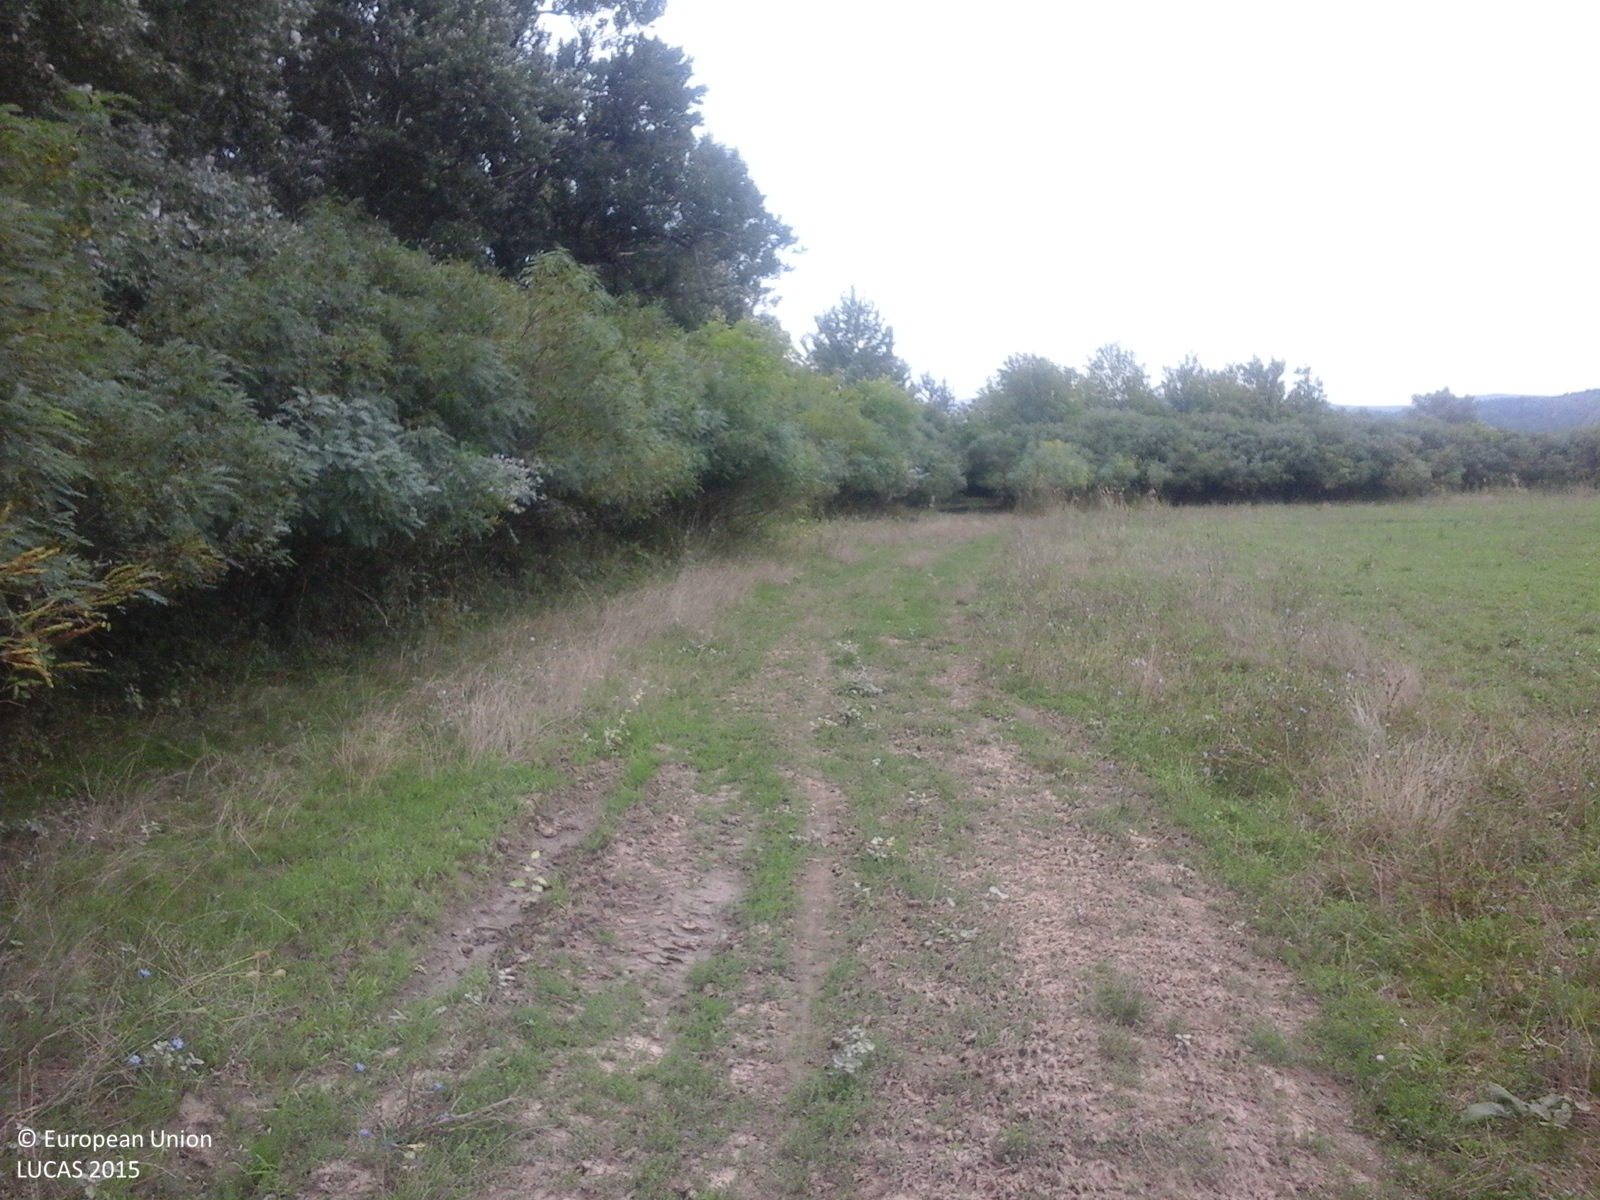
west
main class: Cropland
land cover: Lucerne
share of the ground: > 75 %
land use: Agriculture (excluding fallow land and kitchen gardens)
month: August
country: RO
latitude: 46.0925
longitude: 21.6654
